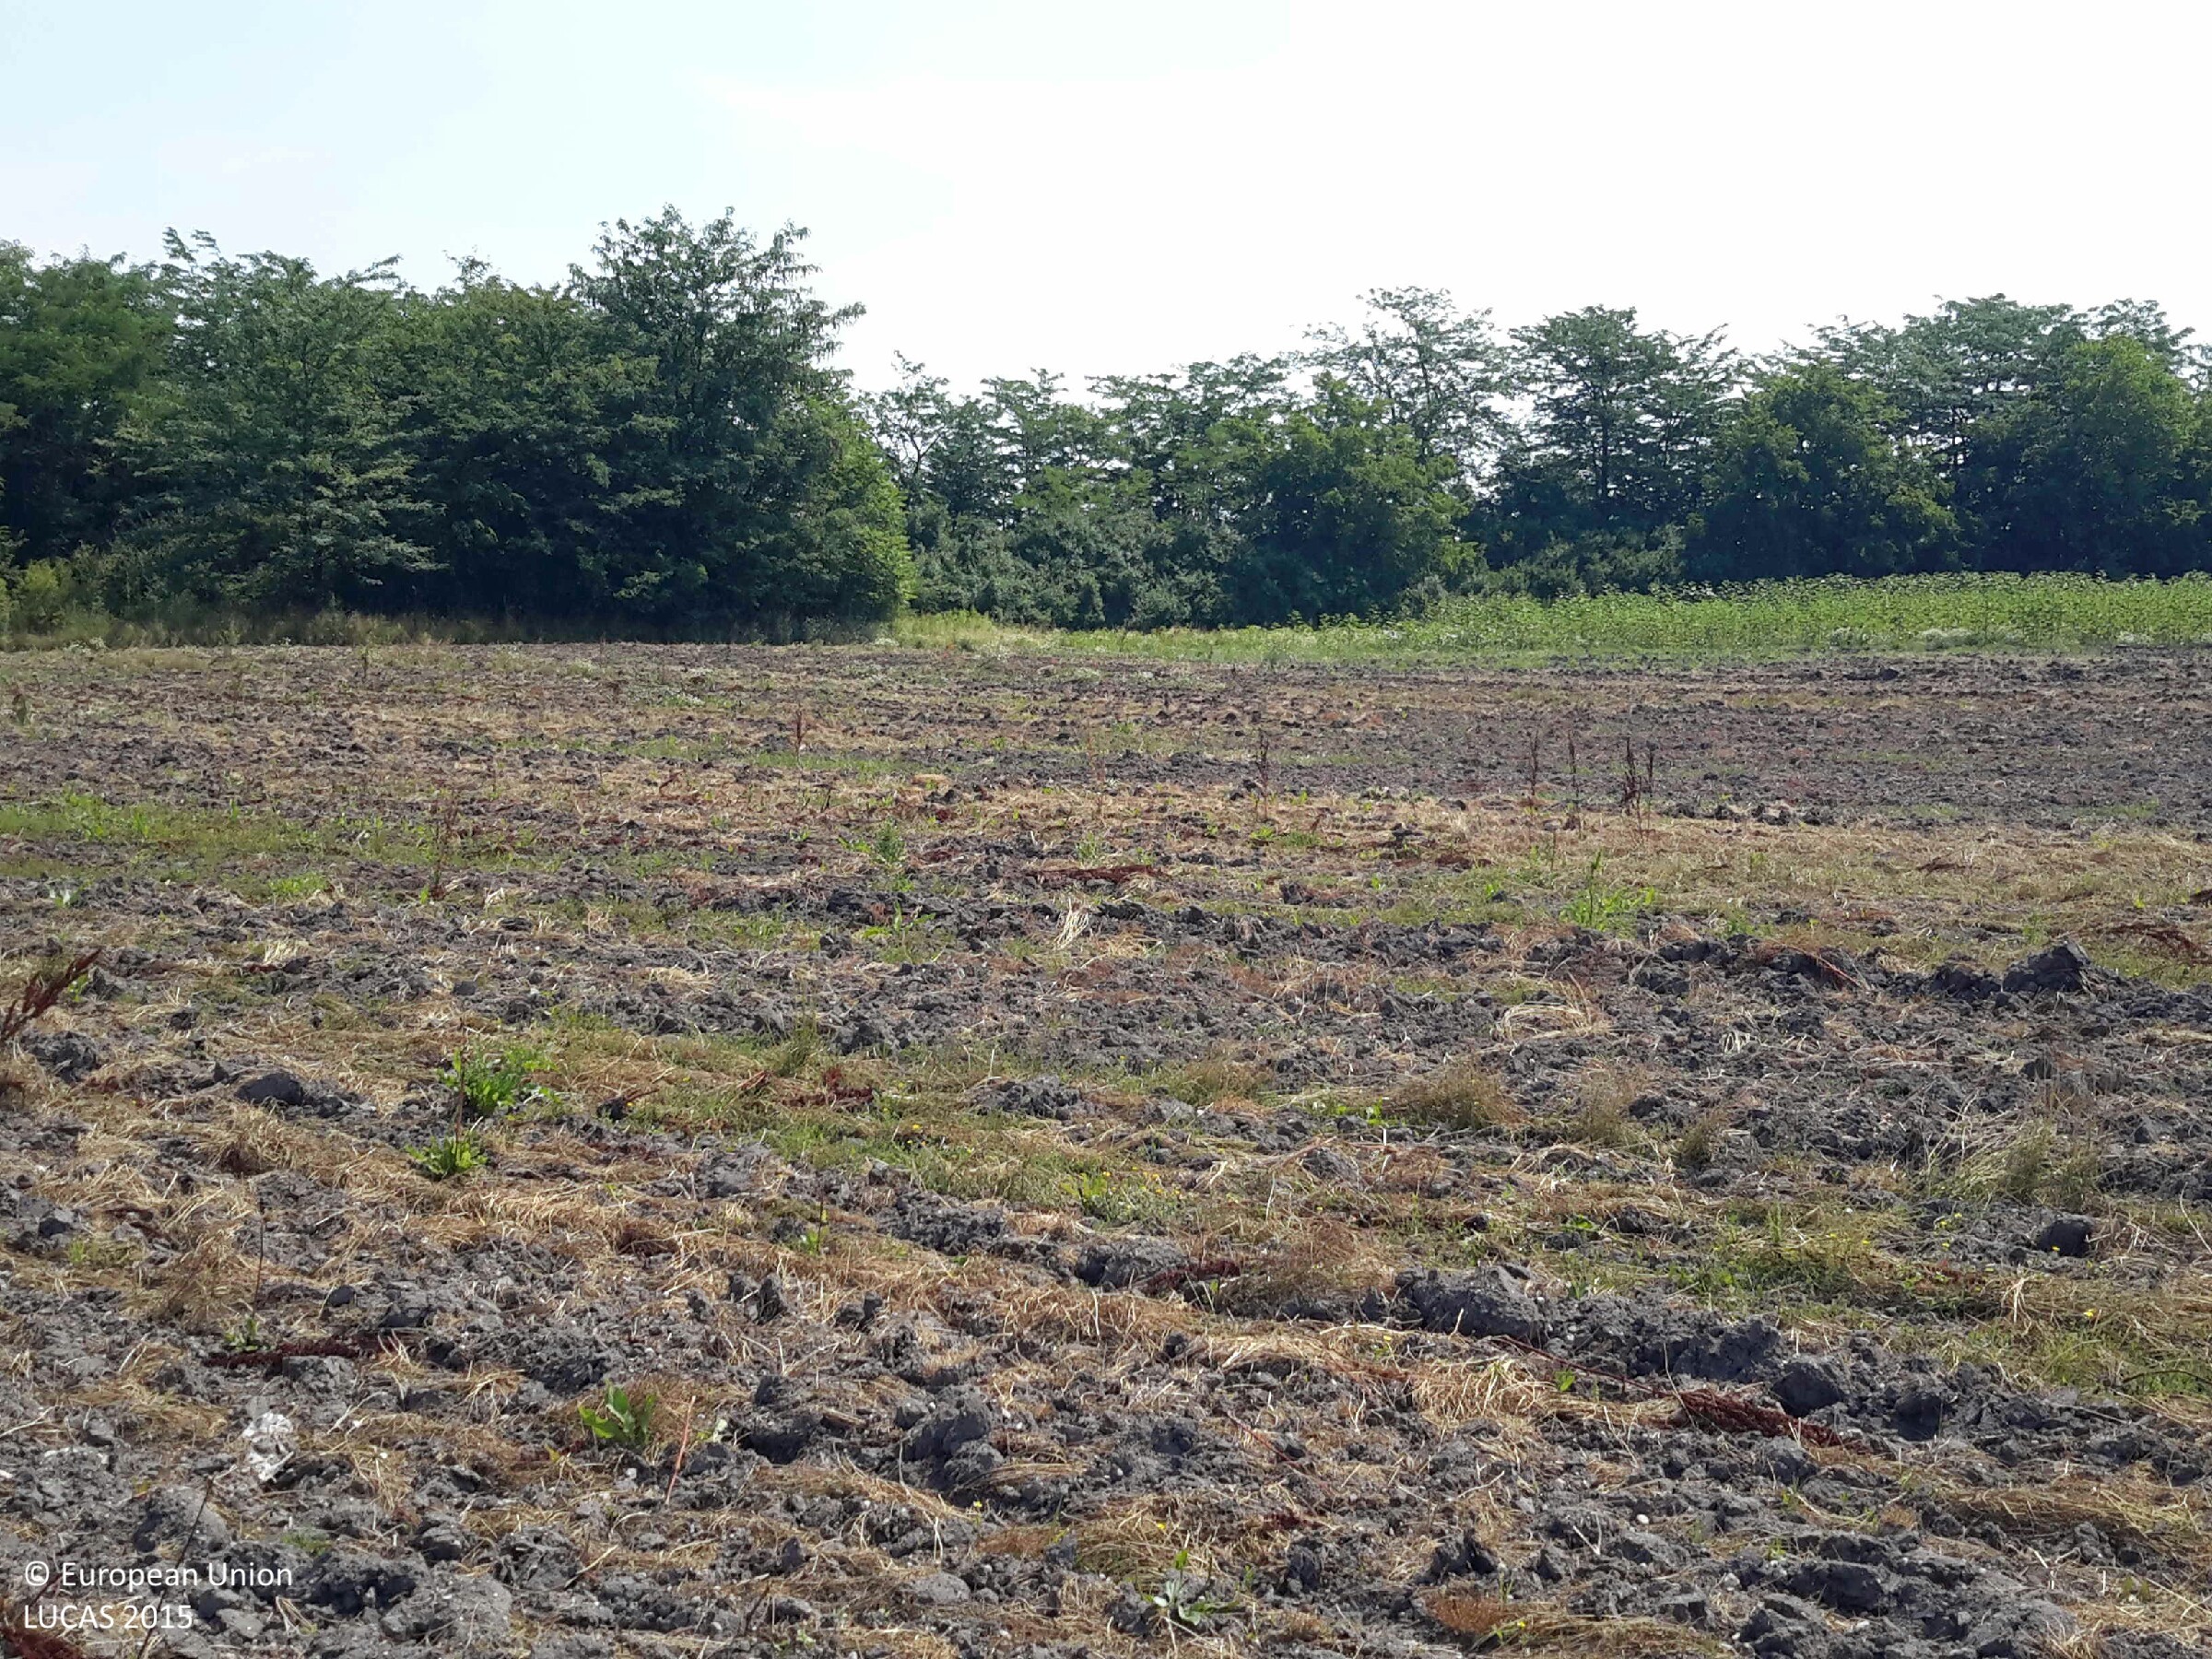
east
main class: Grassland
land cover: Spontaneously vegetated surfaces
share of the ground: 10 - 25 %
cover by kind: unconsolidated bare surface 90 %, herbaceous plants 10 %
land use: Fallow land
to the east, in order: Spontaneously vegetated surfaces; Sunflower; Broadleaved woodland; Sunflower
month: July
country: HU
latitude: 47.4313
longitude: 17.4186
